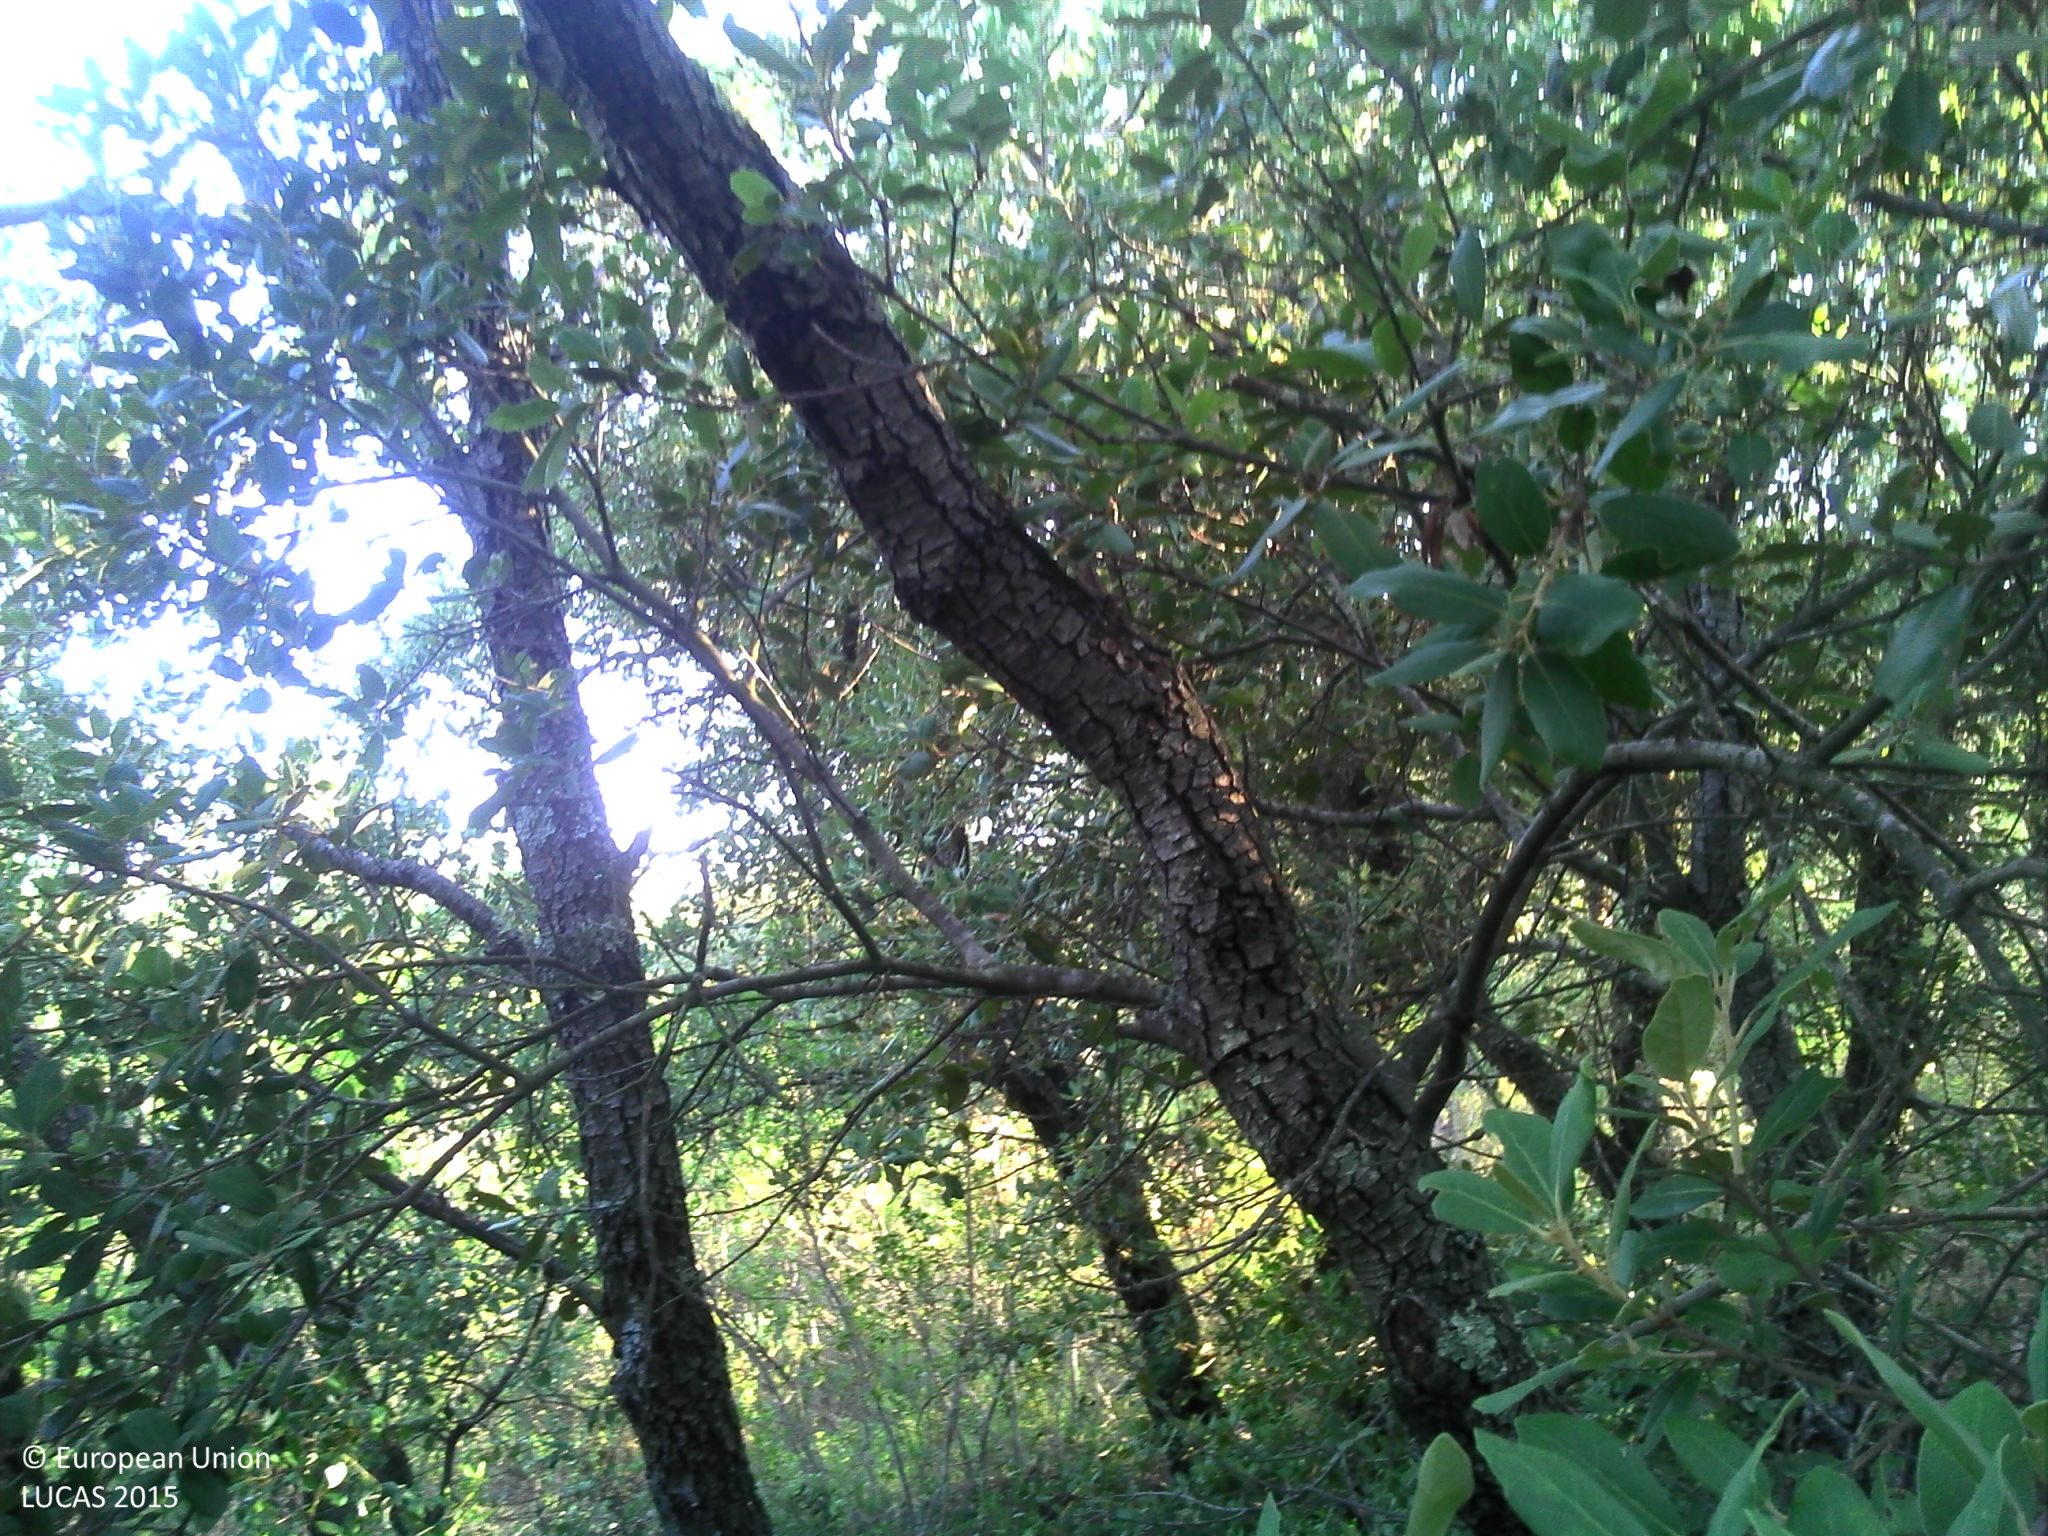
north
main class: Woodland
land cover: Broadleaved woodland
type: thermophilous deciduous forest
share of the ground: > 75 %
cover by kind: broadleaved forest trees 80 %, shrubs 20 %
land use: Semi-natural and natural areas not in use
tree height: > 5 m
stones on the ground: > 50 %
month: August
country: FR
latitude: 43.5405
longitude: 5.7397
